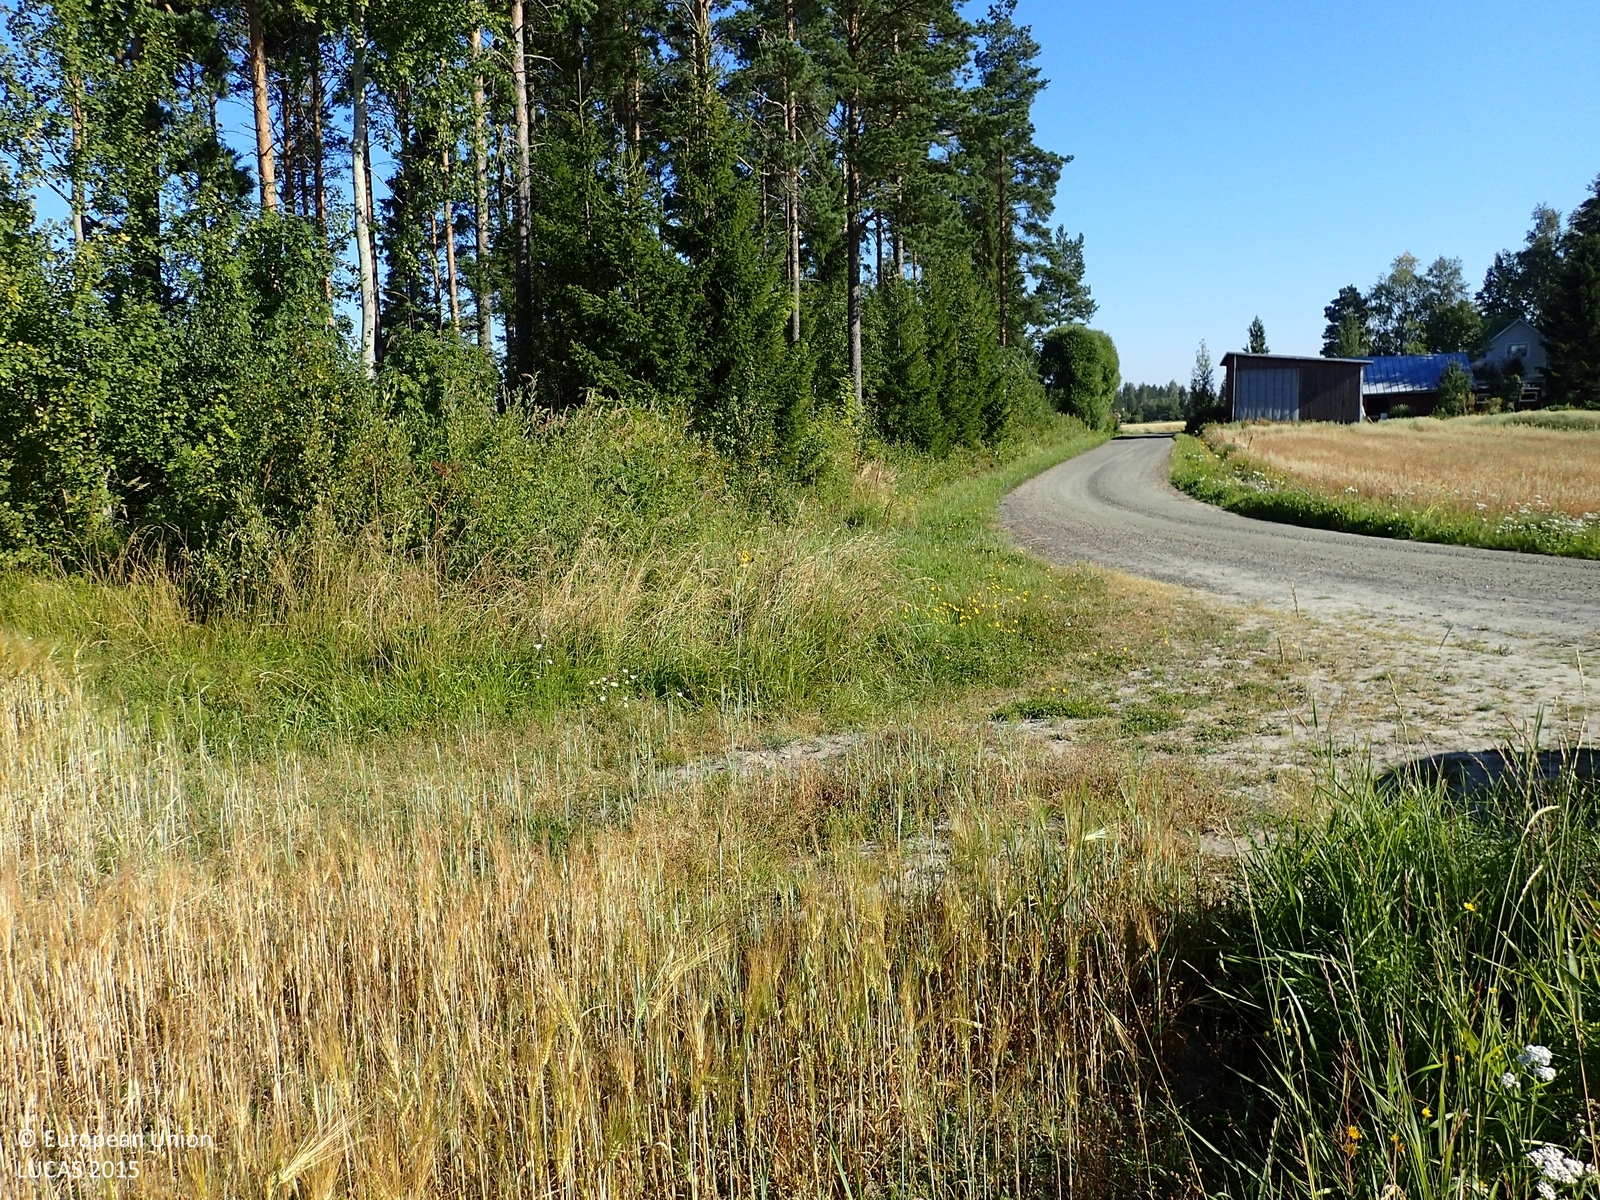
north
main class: Cropland
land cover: Barley
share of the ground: > 75 %
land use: Agriculture (excluding fallow land and kitchen gardens)
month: August
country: FI
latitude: 62.4916
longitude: 21.8273
